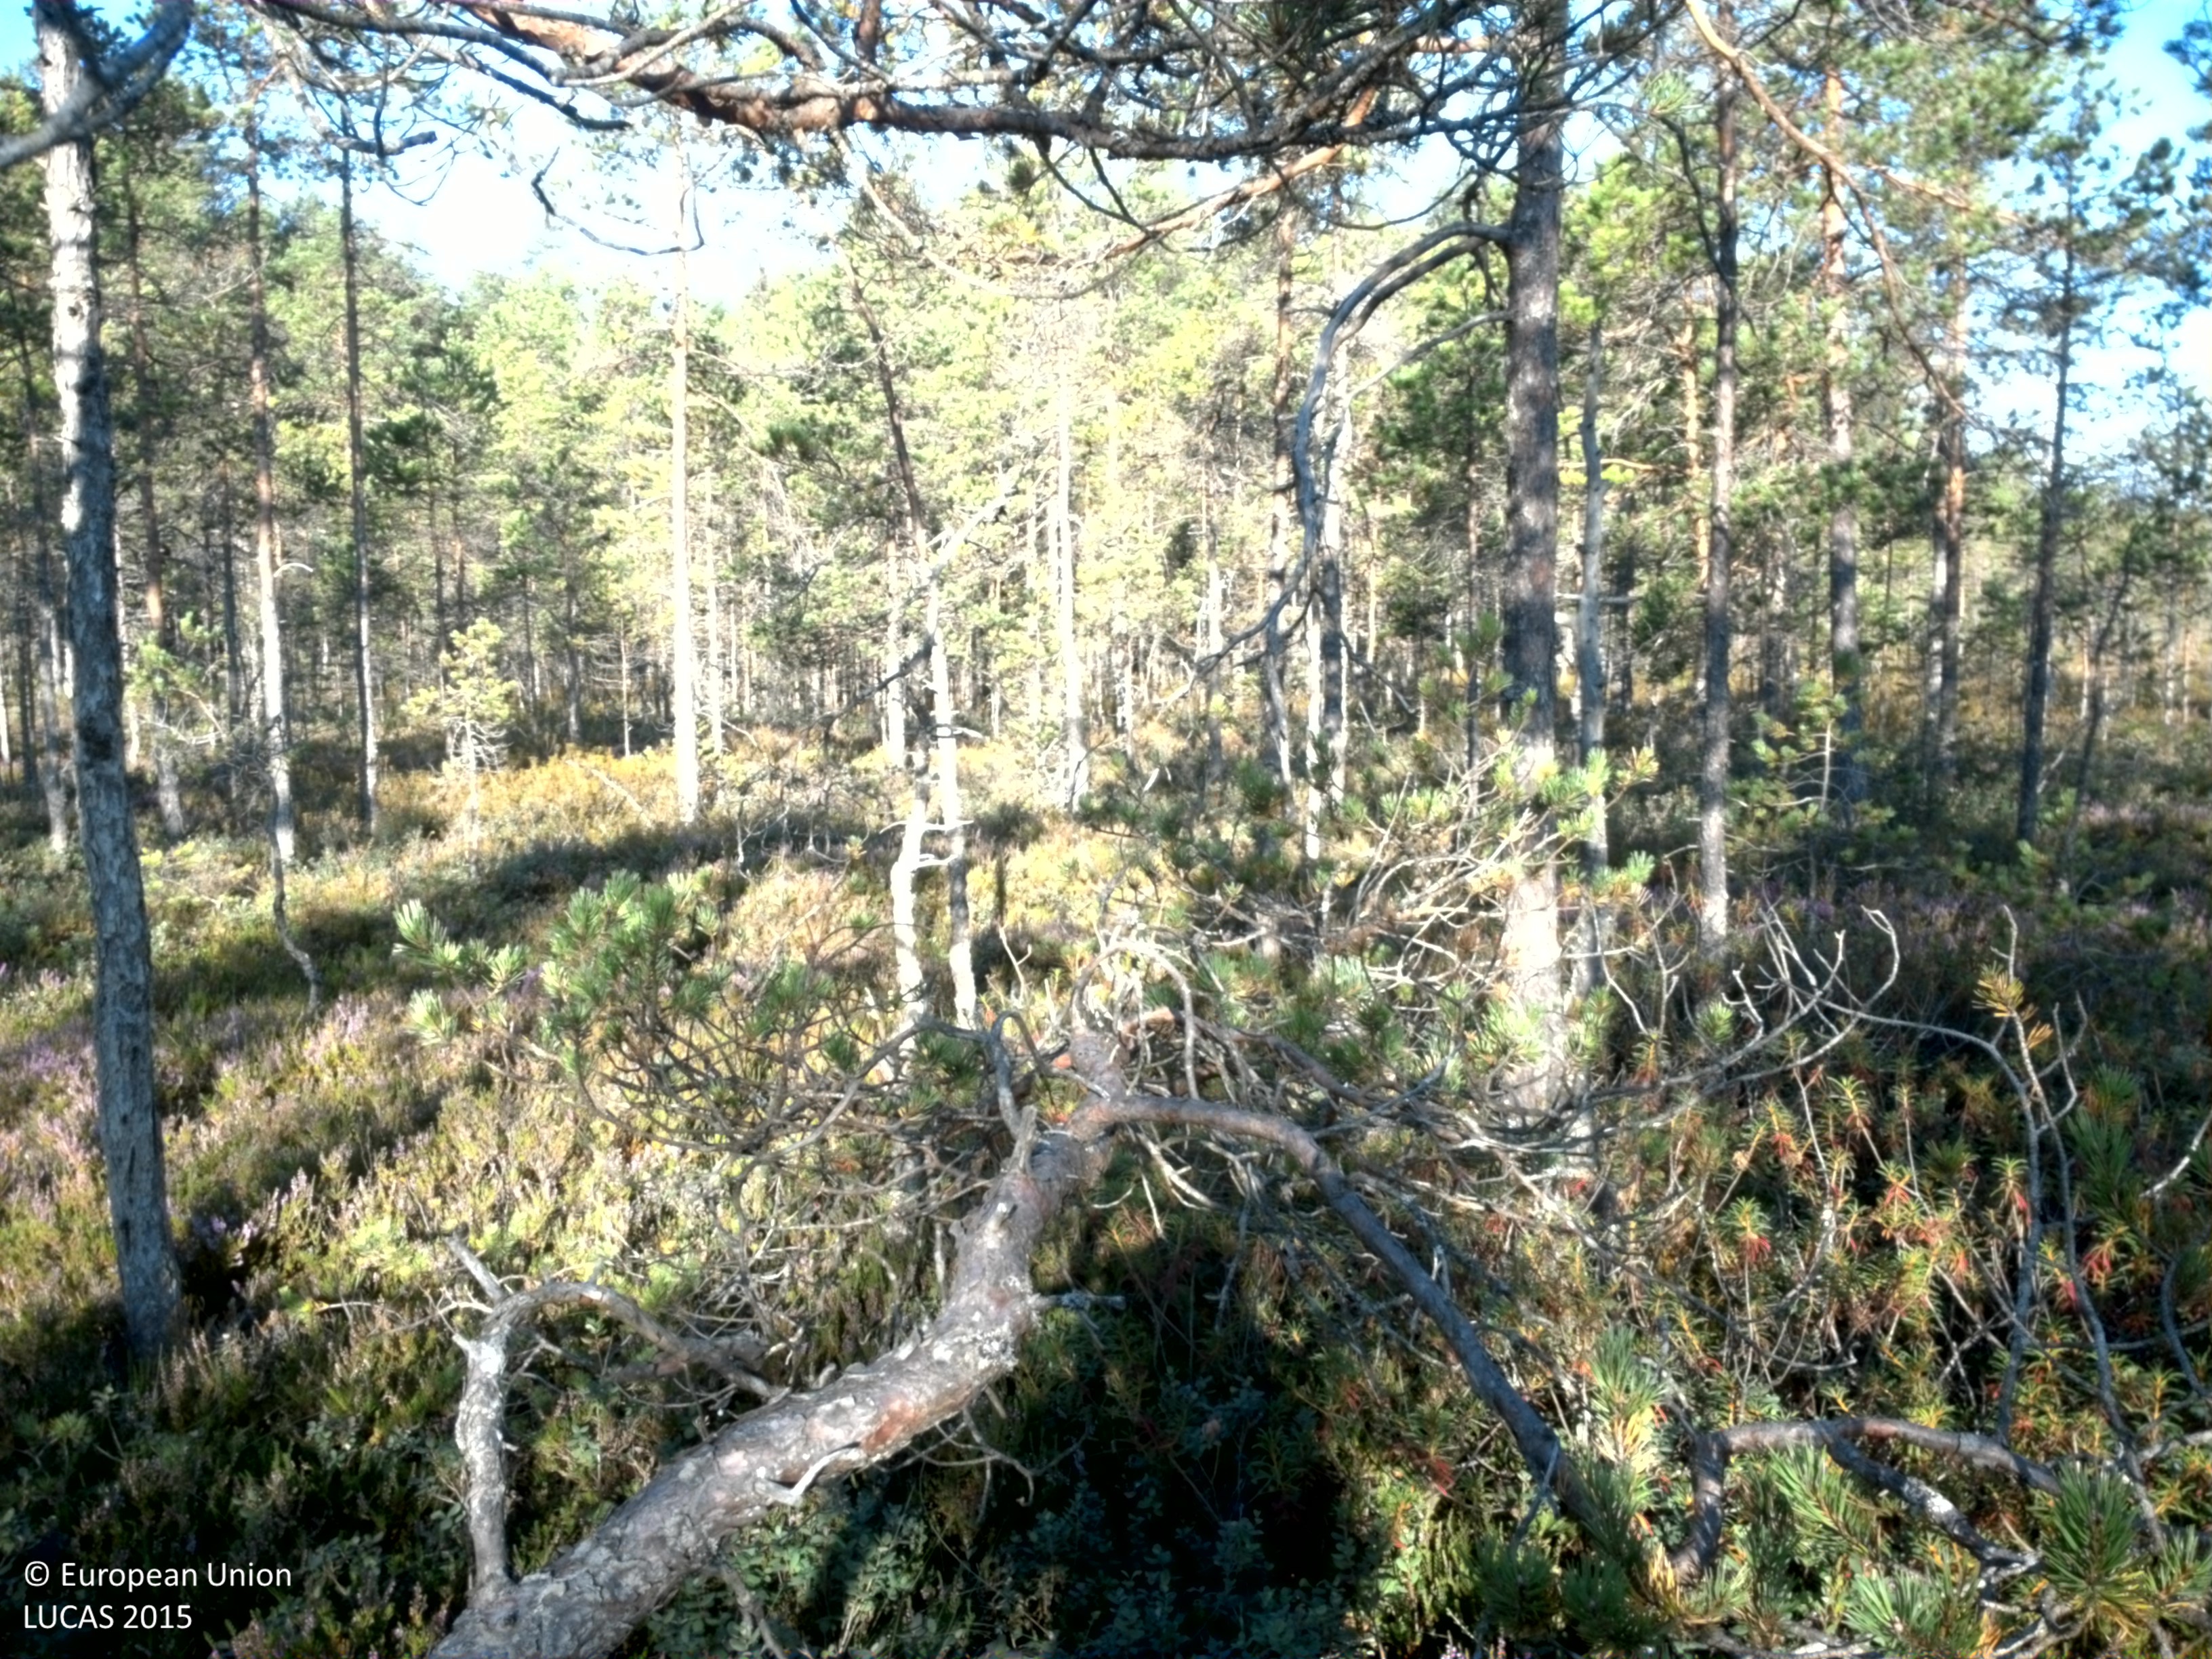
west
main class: Woodland
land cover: Pine dominated coniferous woodland
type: mire and swamp forests
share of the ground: 25 - 50 %
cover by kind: shrubs 50 %, coniferous forest trees 45 %, lichens and mosses 5 %
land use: Semi-natural and natural areas not in use
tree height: < 5 m
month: August
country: SE
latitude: 59.7645
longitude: 15.9906
